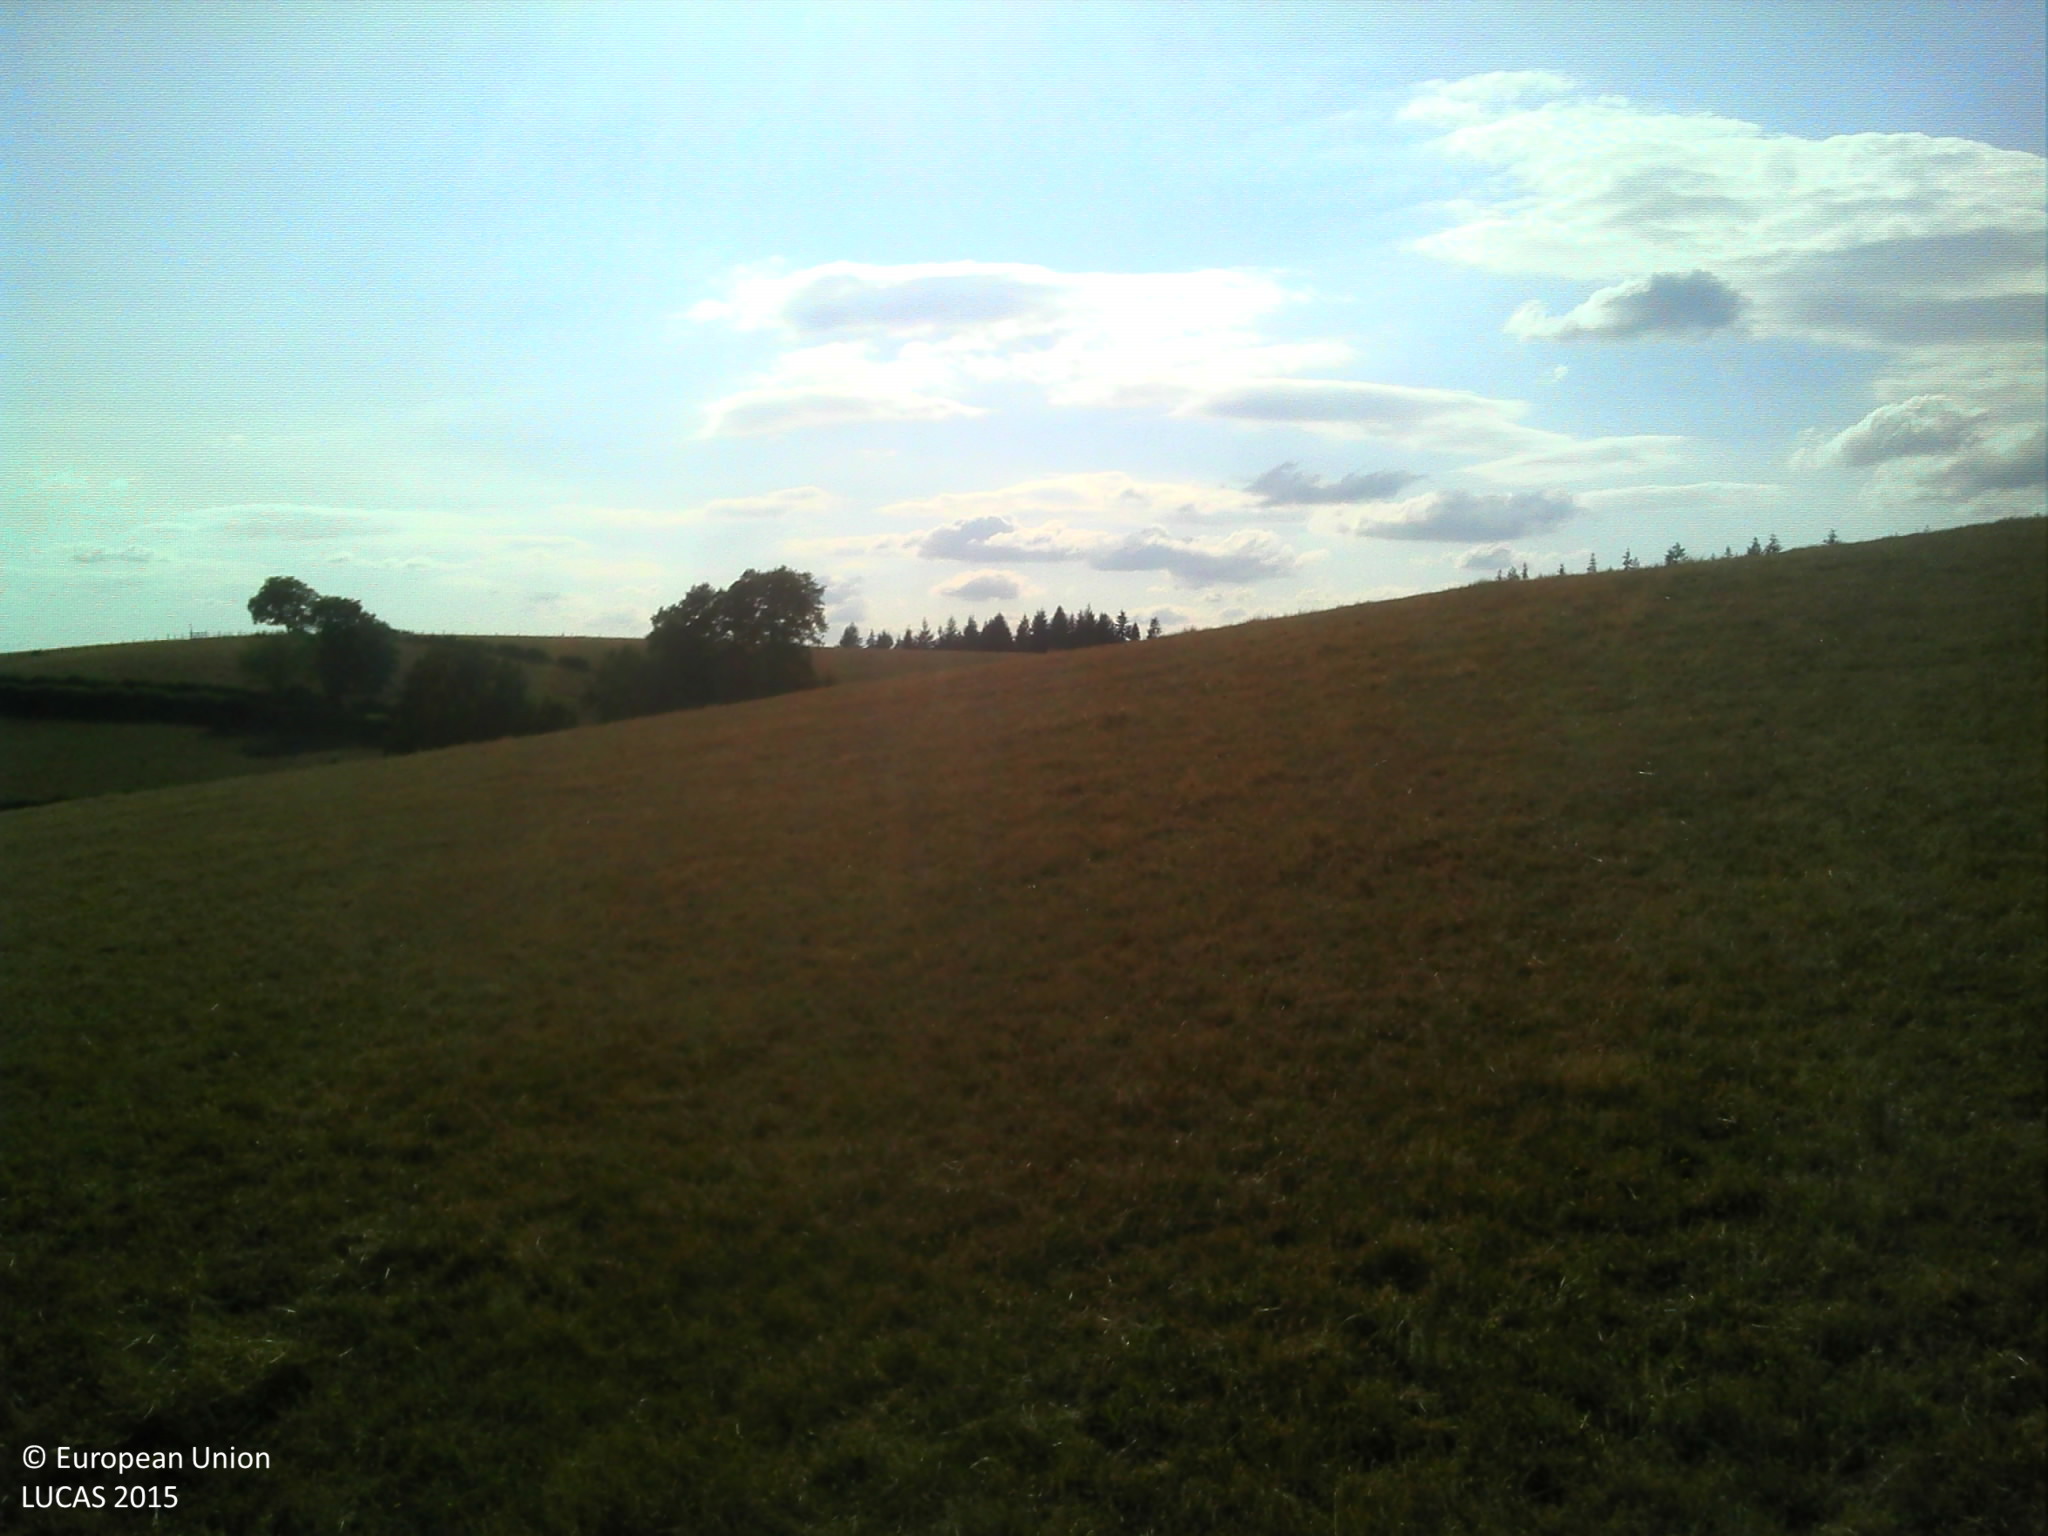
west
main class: Grassland
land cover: Grassland without tree/shrub cover
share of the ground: > 75 %
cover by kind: herbaceous plants 100 %
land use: Agriculture (excluding fallow land and kitchen gardens)
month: July
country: FR
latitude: 46.6183
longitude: 4.3725
